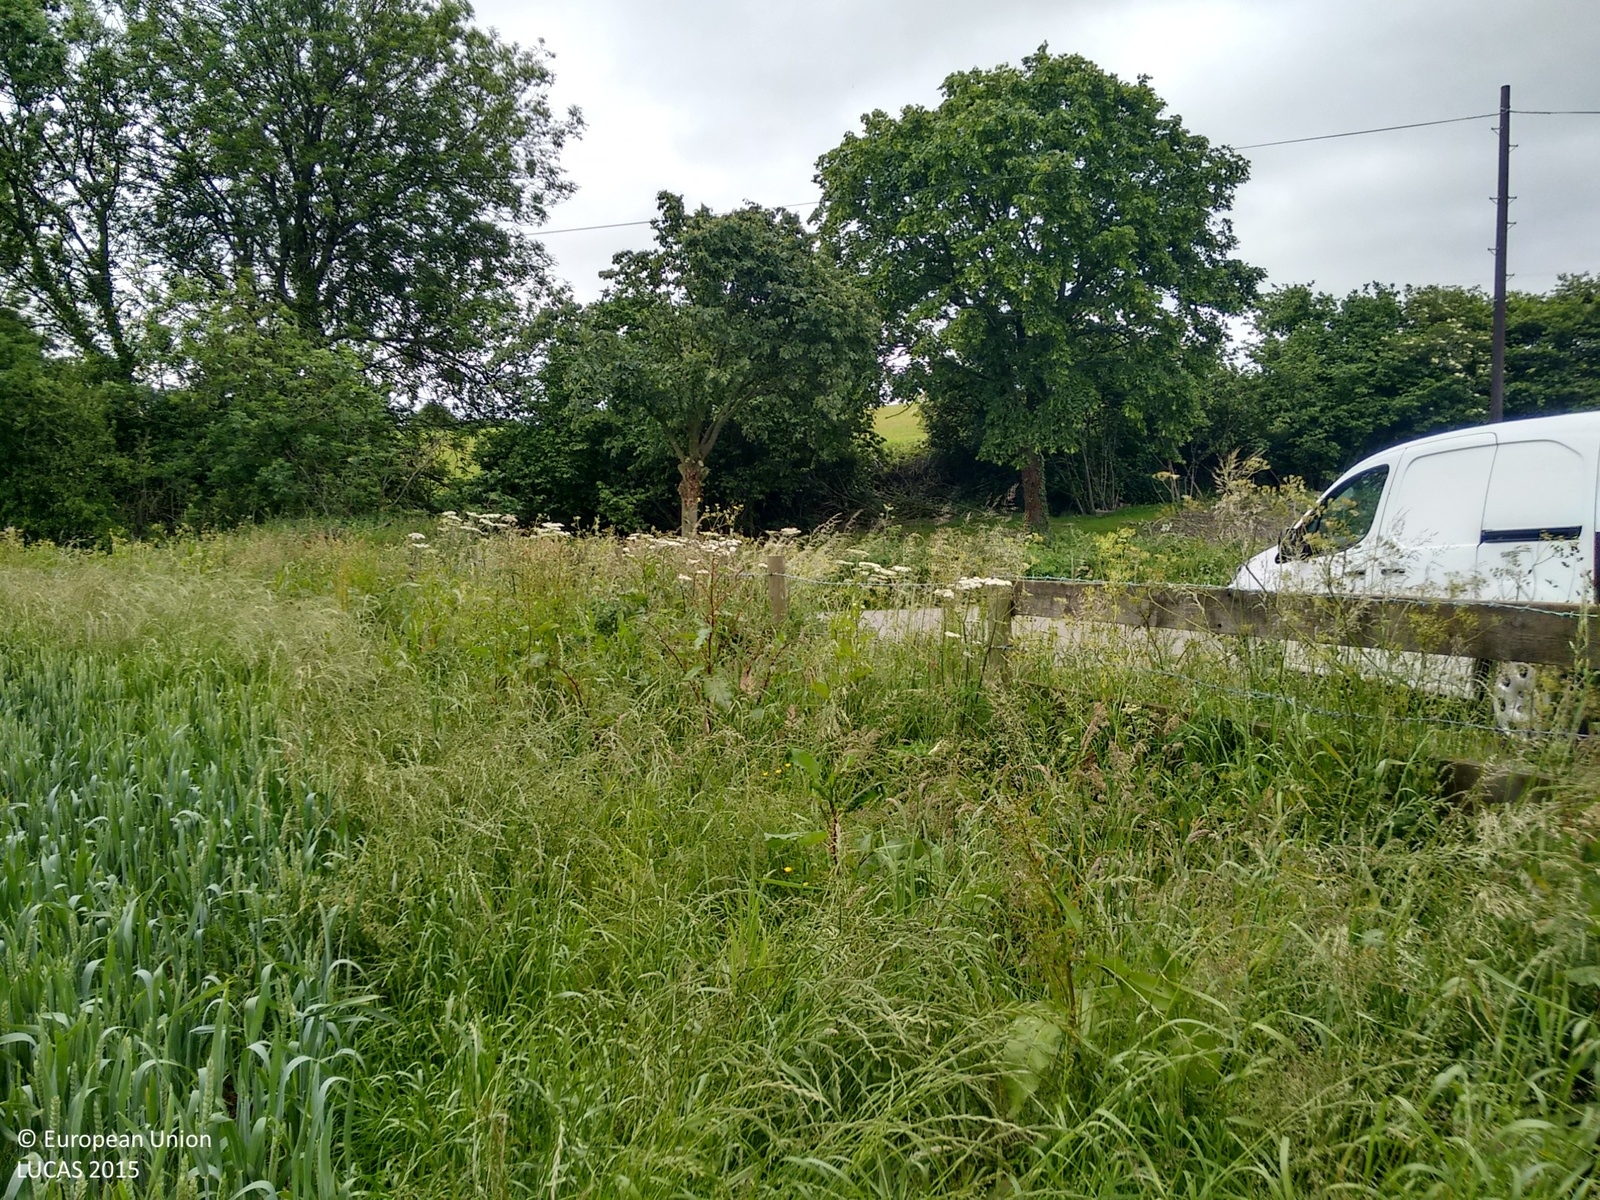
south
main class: Cropland
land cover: Common wheat
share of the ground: > 75 %
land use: Agriculture (excluding fallow land and kitchen gardens)
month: June
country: GB
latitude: 51.0651
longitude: -2.4371
